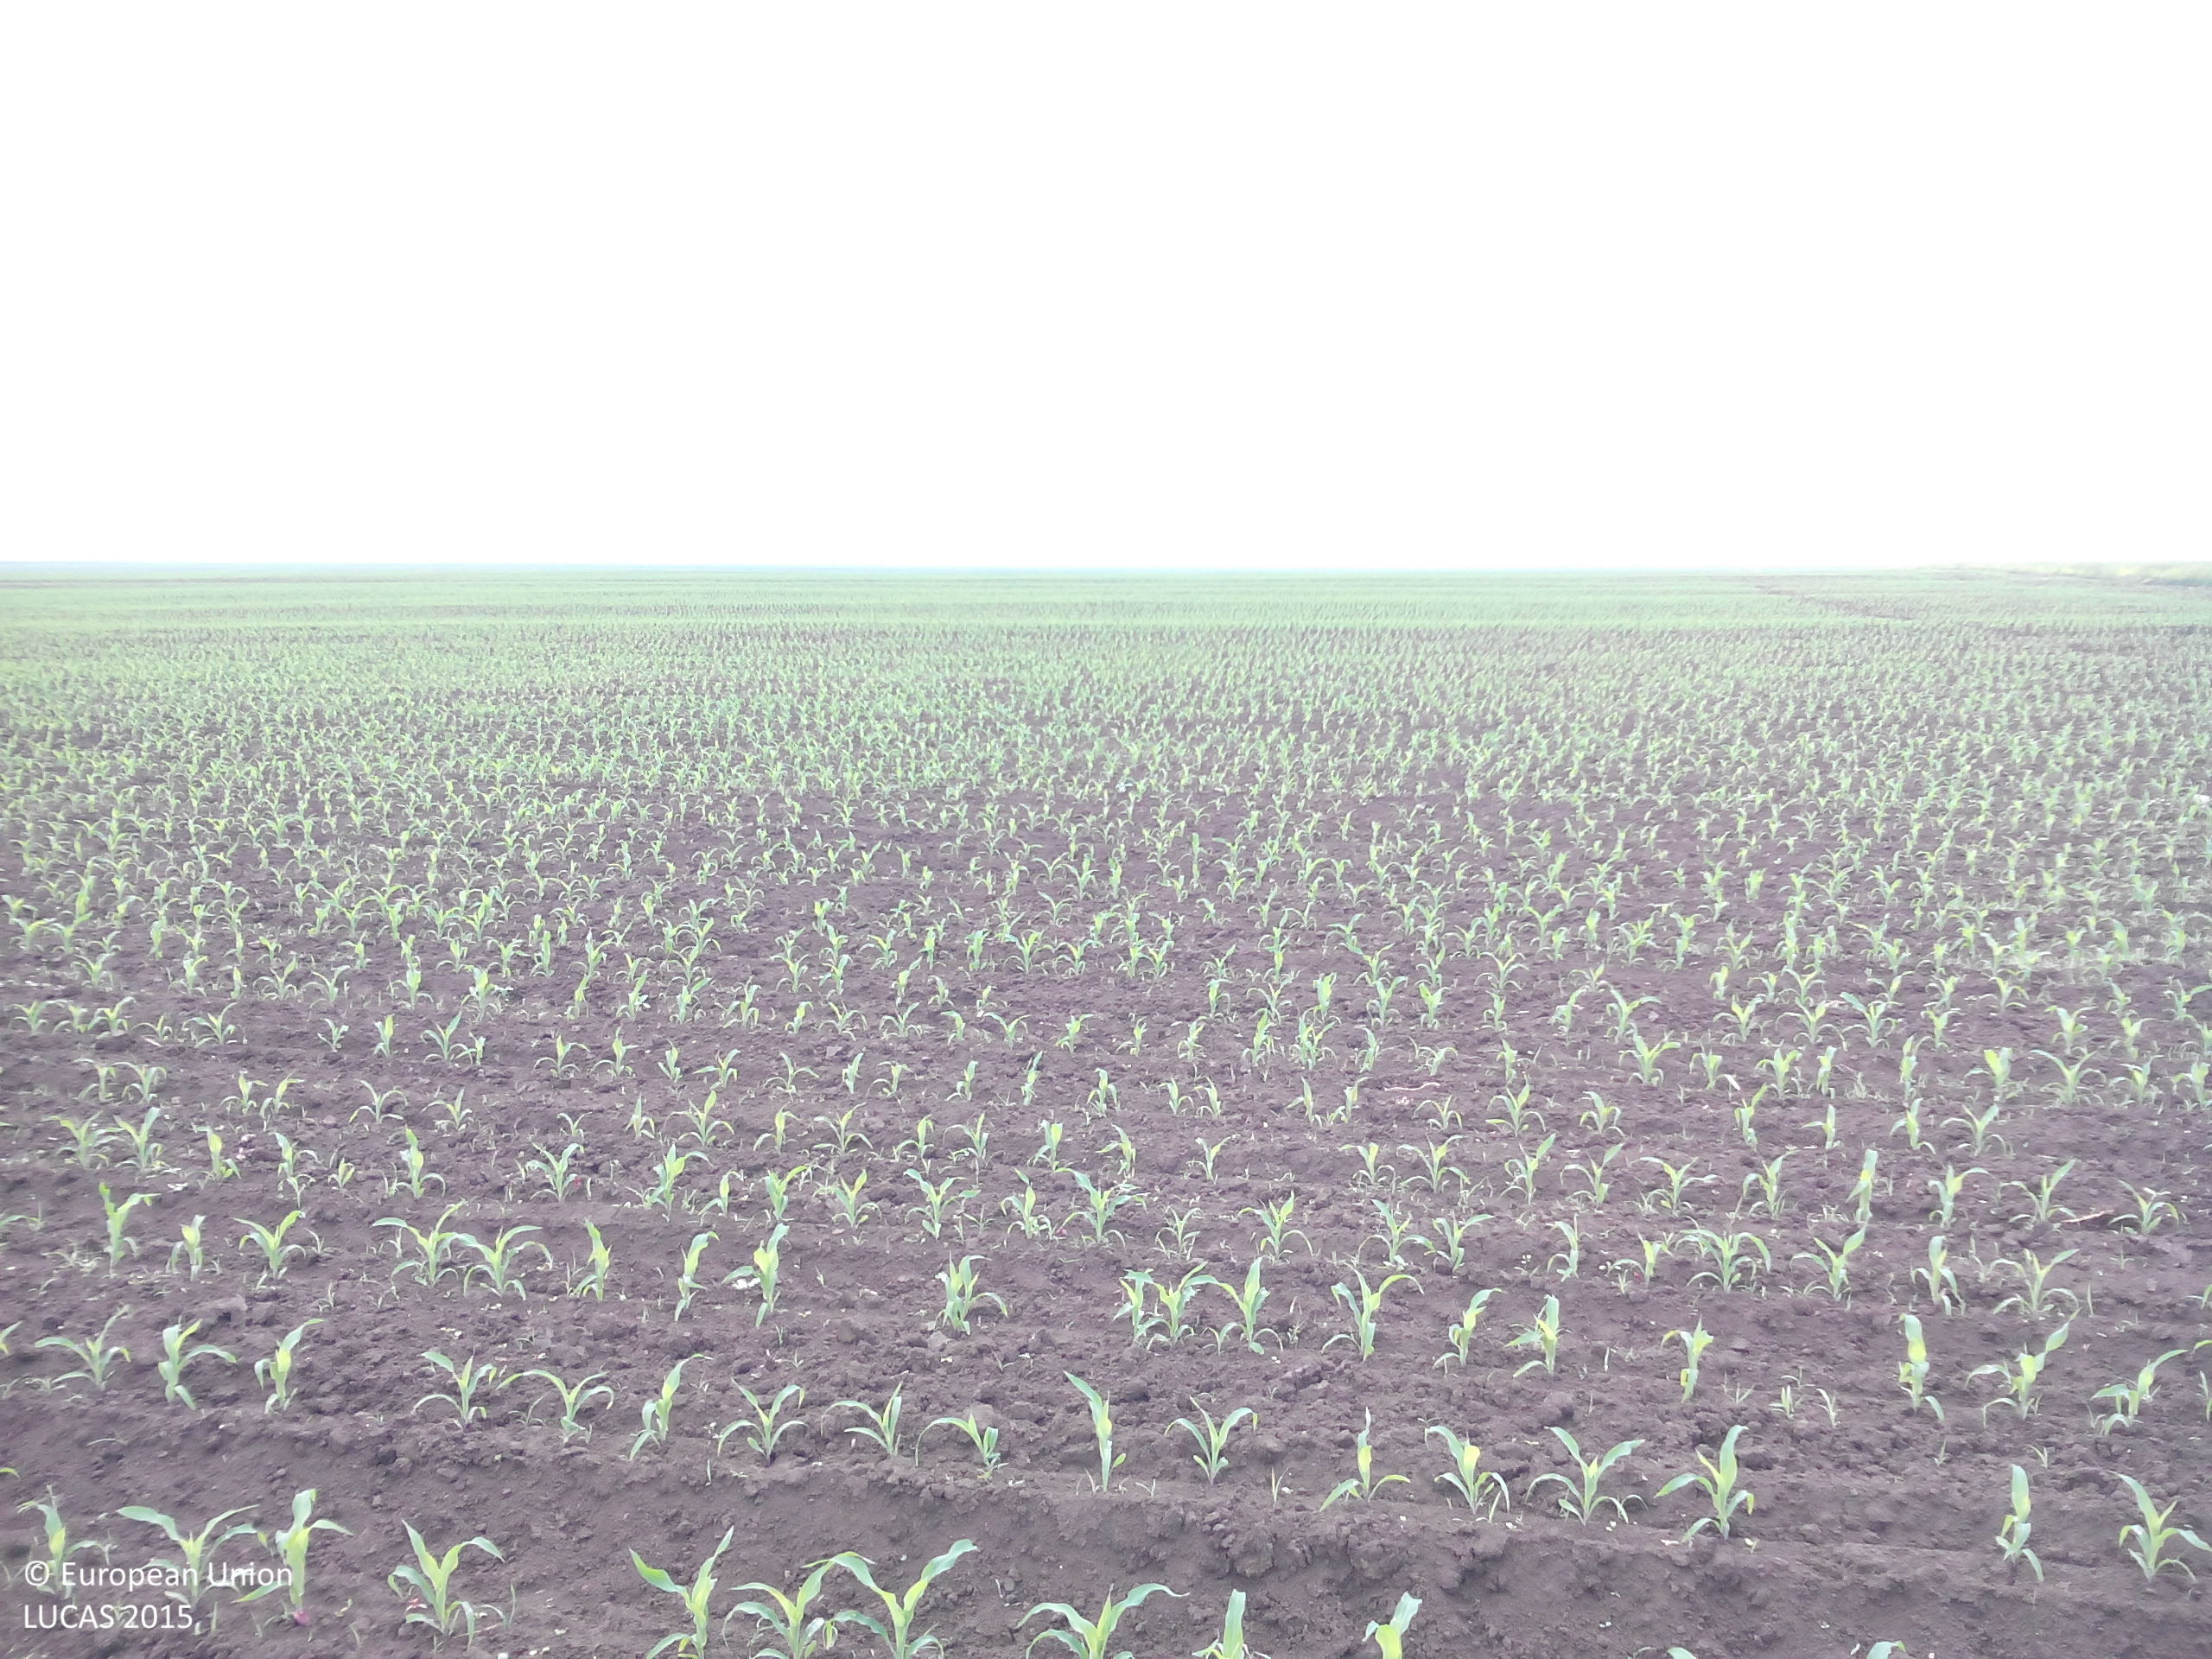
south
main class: Cropland
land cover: Maize
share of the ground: 10 - 25 %
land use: Agriculture (excluding fallow land and kitchen gardens)
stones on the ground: < 10 %
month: May
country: BG
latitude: 43.6141
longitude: 23.7414
